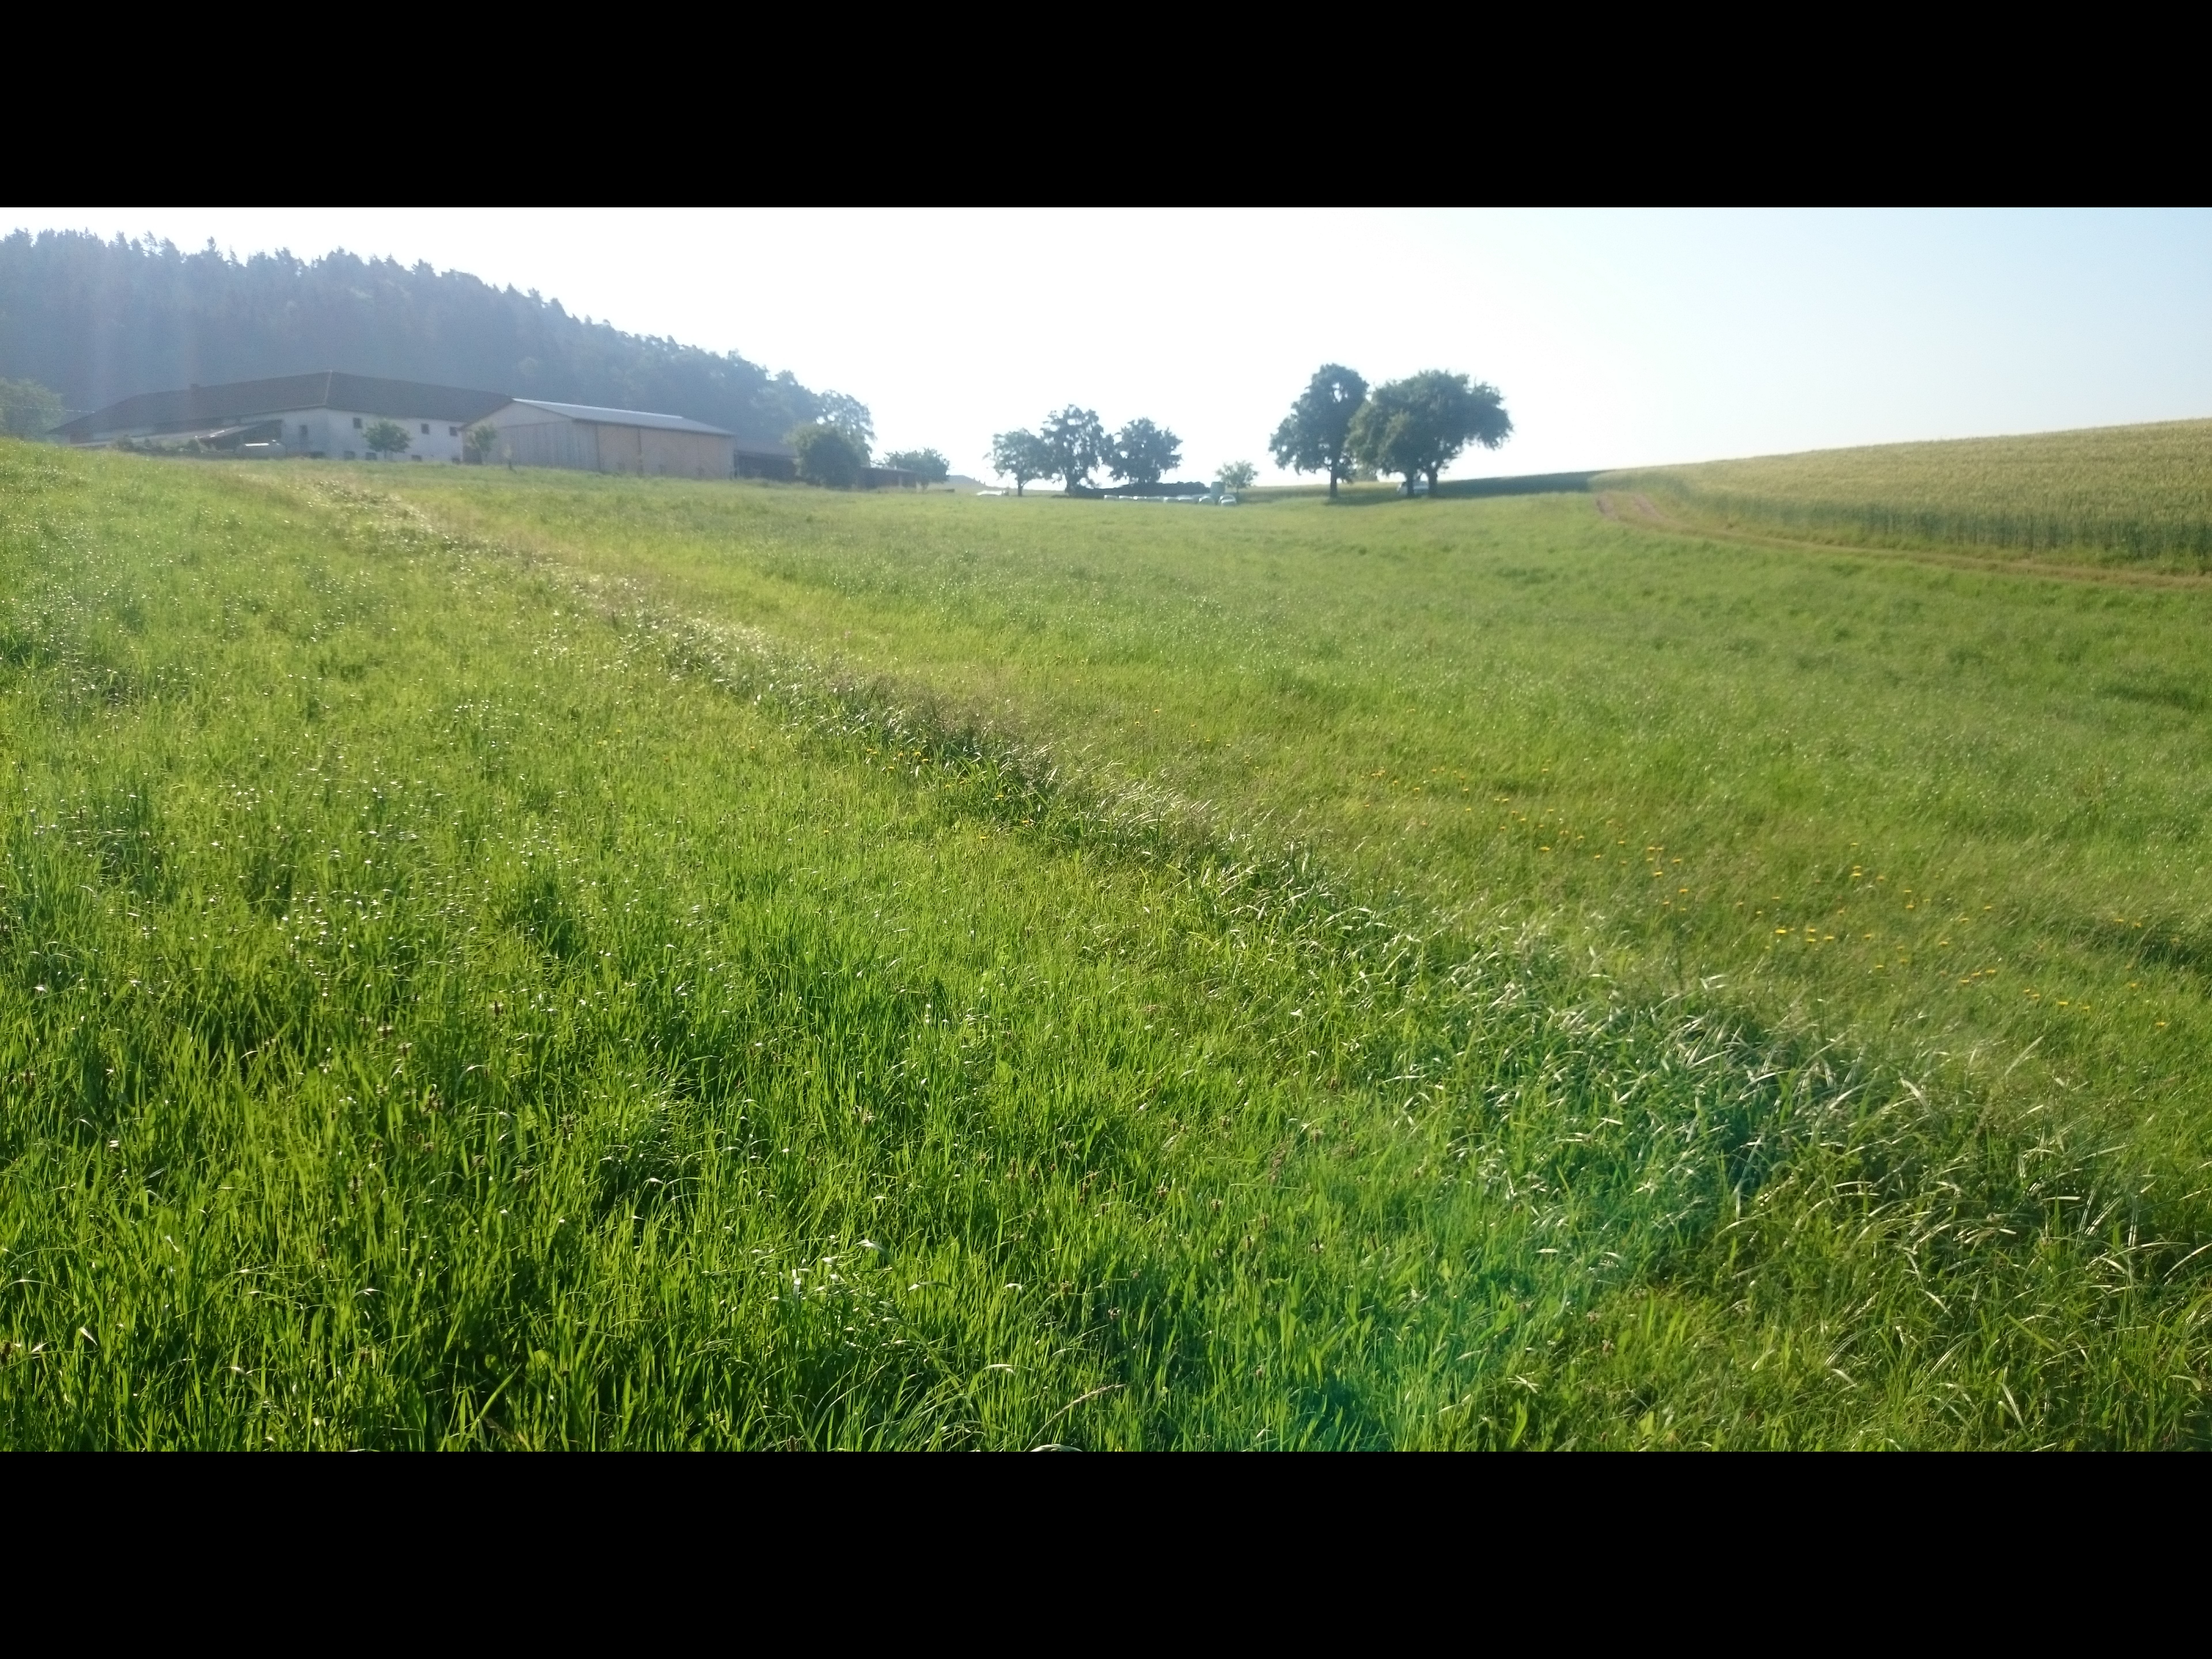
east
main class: Grassland
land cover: Grassland without tree/shrub cover
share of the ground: > 75 %
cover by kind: herbaceous plants 100 %
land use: Agriculture (excluding fallow land and kitchen gardens)
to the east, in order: Grassland without tree/shrub cover; Electric lines; Ditches and canals; Grassland without tree/shrub cover; Artificial constructions in urban areas; Grassland without tree/shrub cover
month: June
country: AT
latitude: 48.3819
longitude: 14.5509
